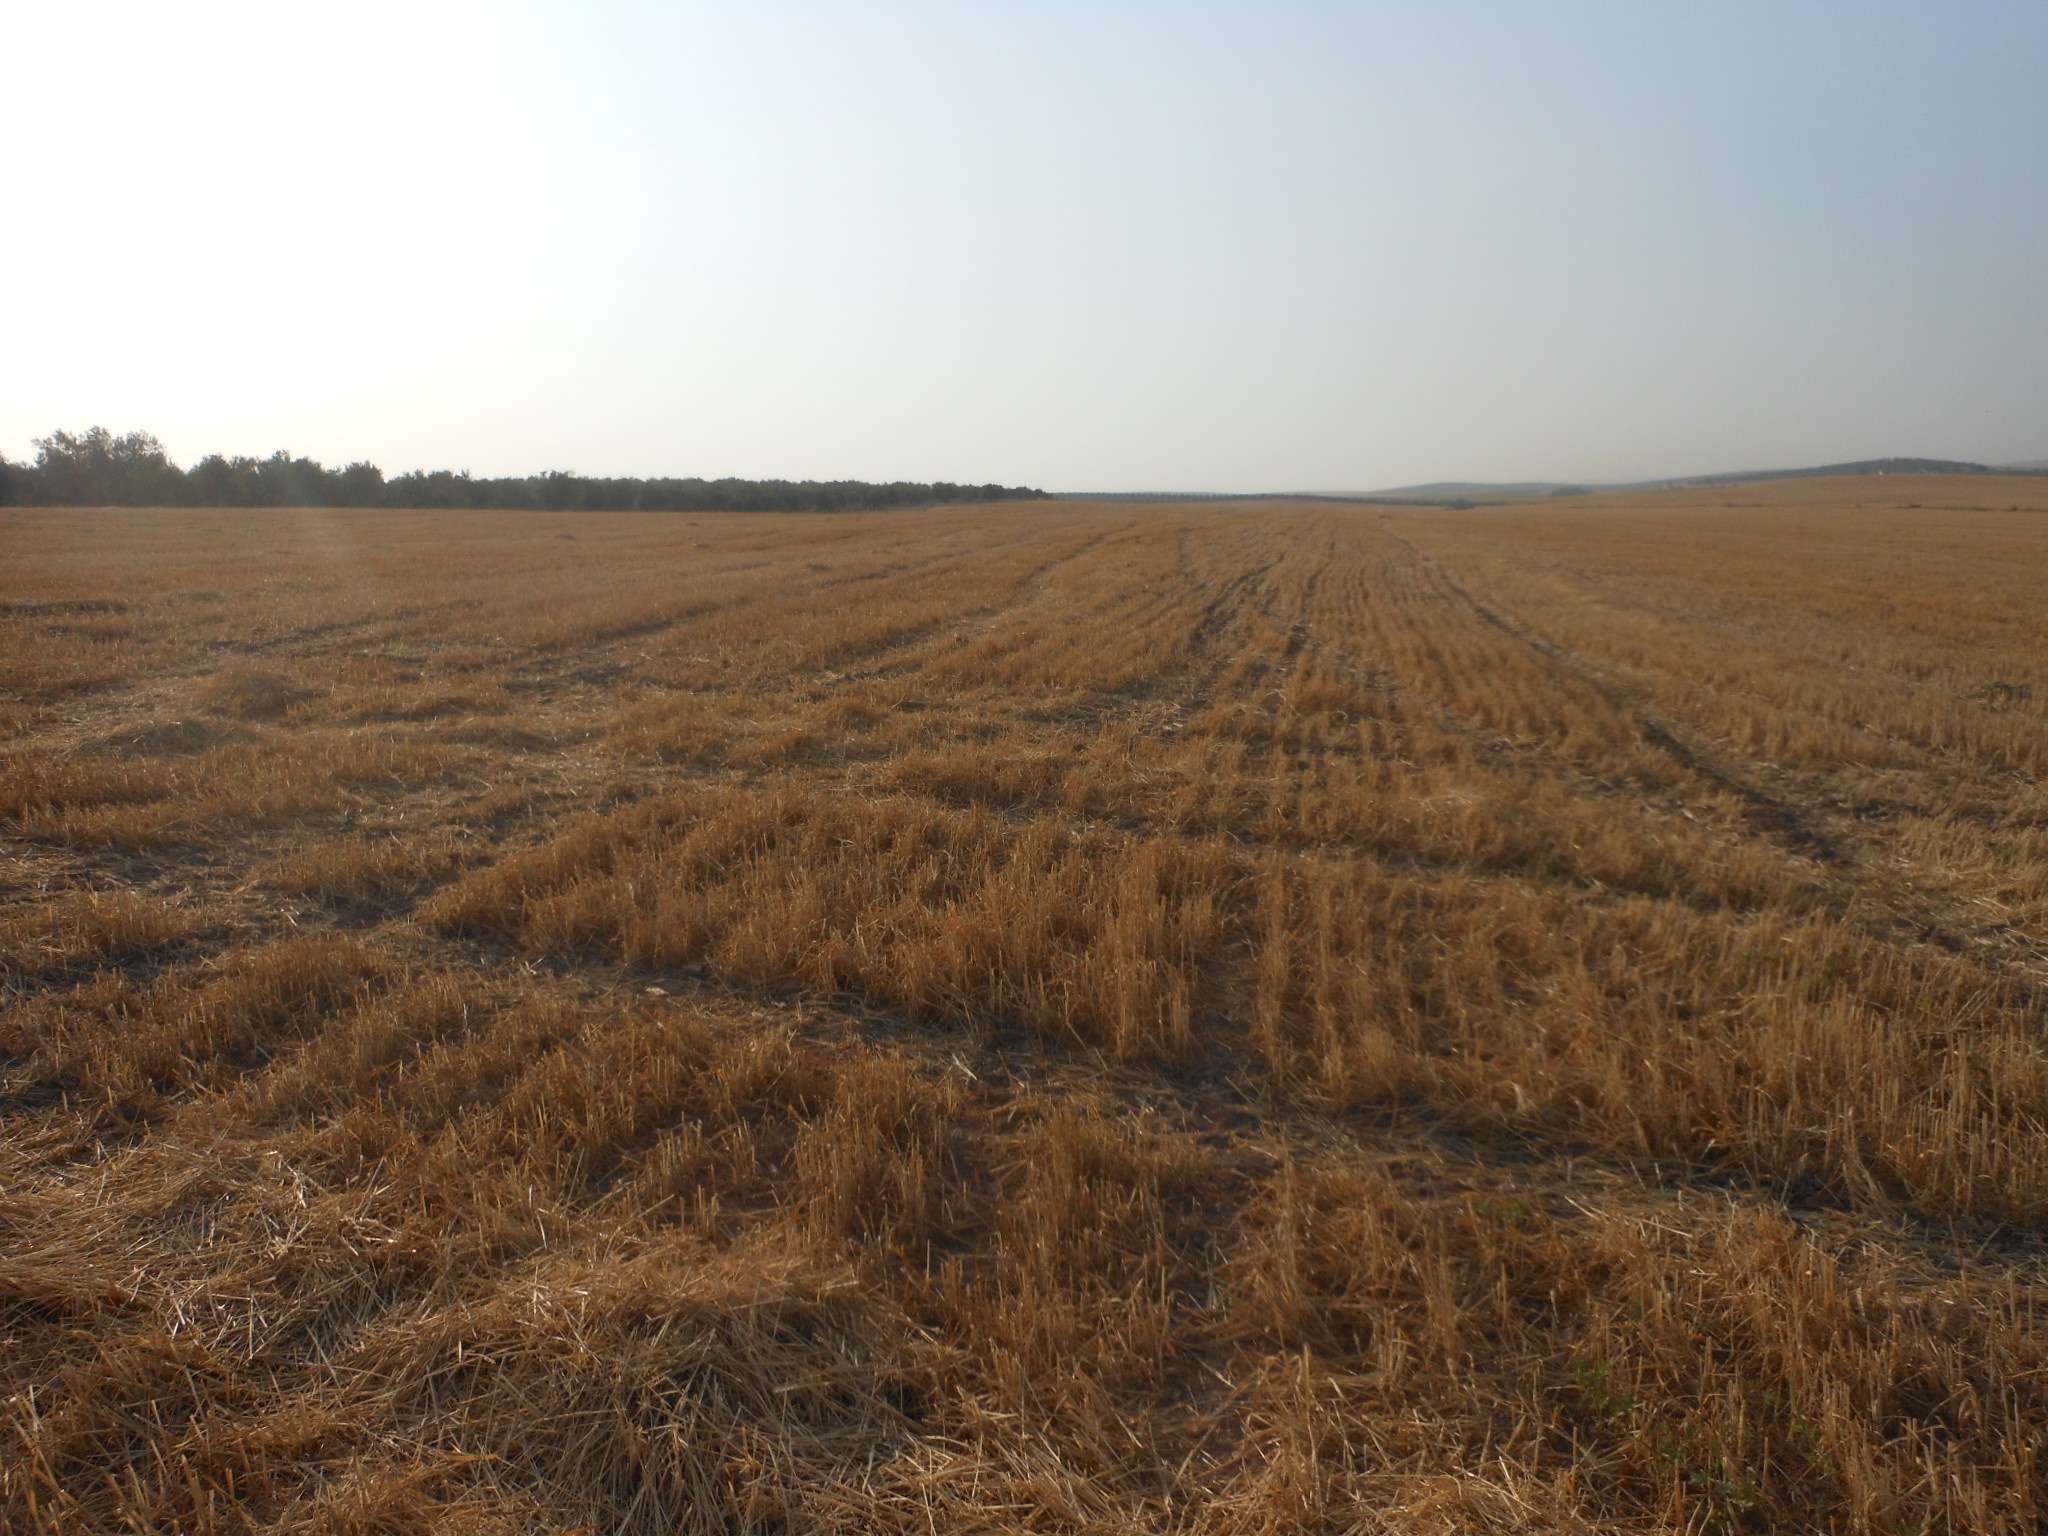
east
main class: Cropland
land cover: Durum wheat
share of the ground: < 10 %
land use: Agriculture (excluding fallow land and kitchen gardens)
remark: Harvested field
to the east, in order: Durum wheat; Tracks; Olive groves
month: June
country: ES
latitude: 37.2729
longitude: -5.0859
